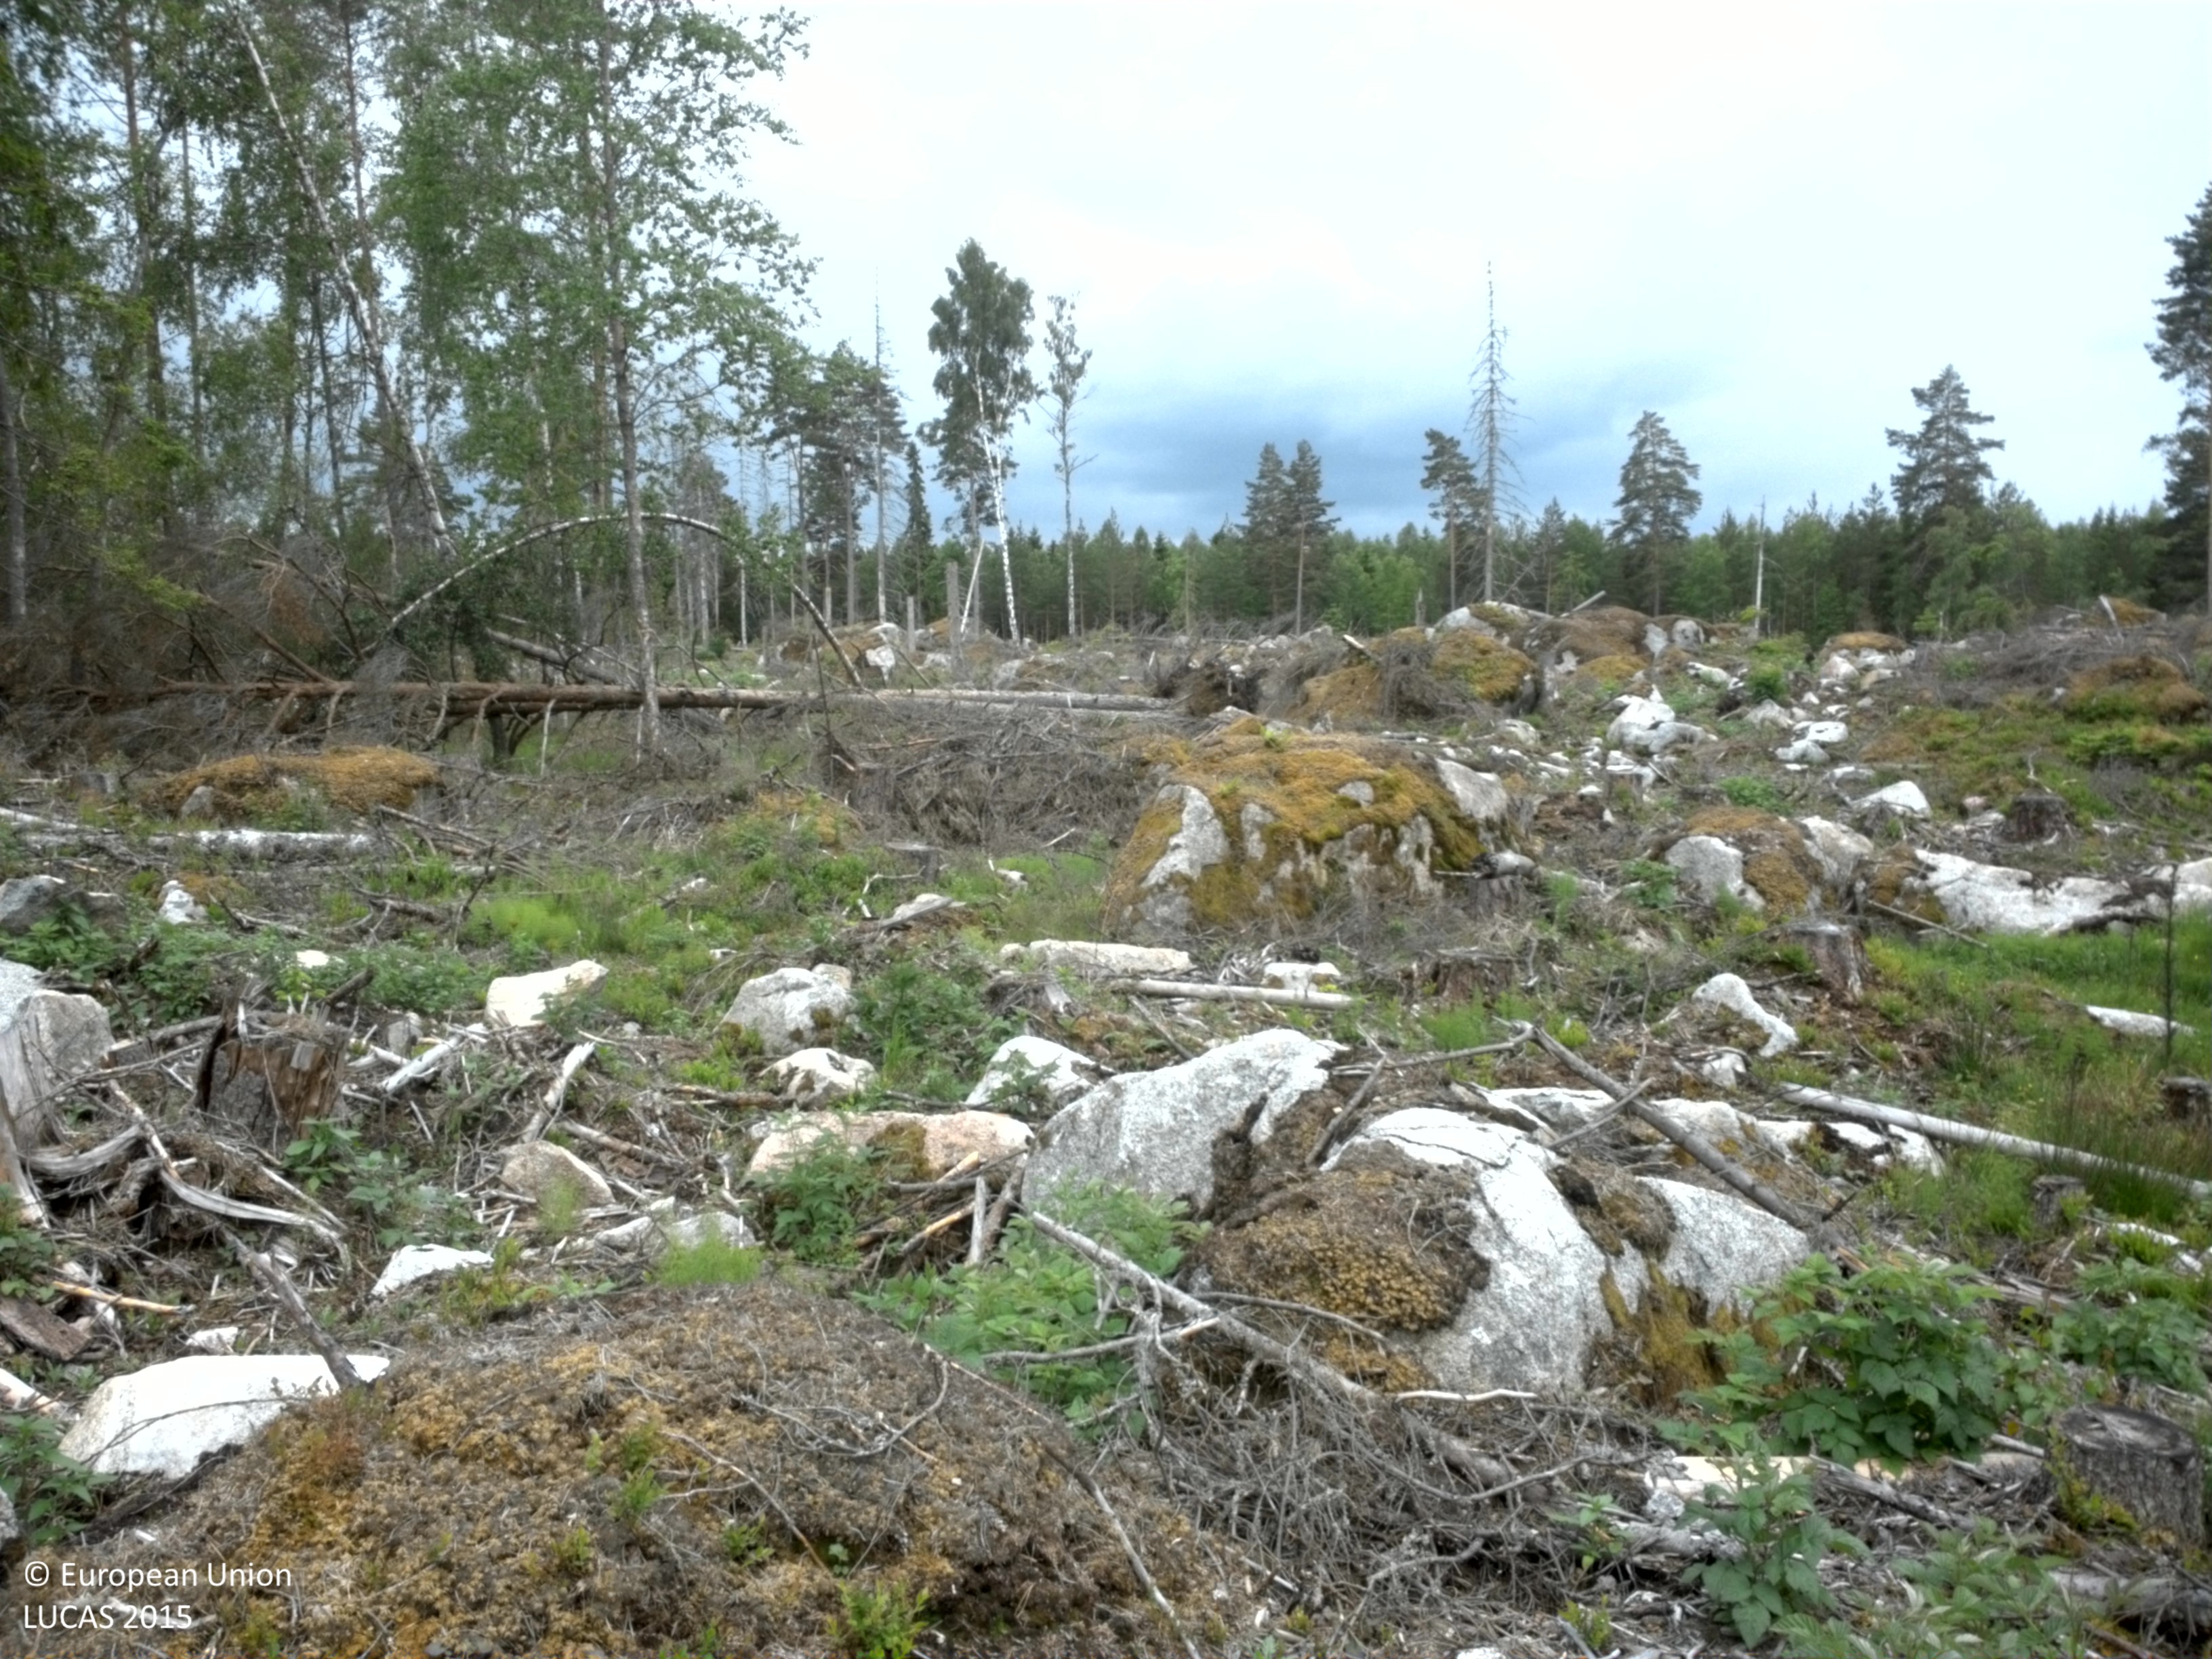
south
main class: Shrubland
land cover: Shrubland without tree cover
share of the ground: < 10 %
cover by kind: lichens and mosses 70 %, herbaceous plants 20 %, shrubs 10 %
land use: Forestry
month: June
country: SE
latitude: 59.6631
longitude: 17.0044
